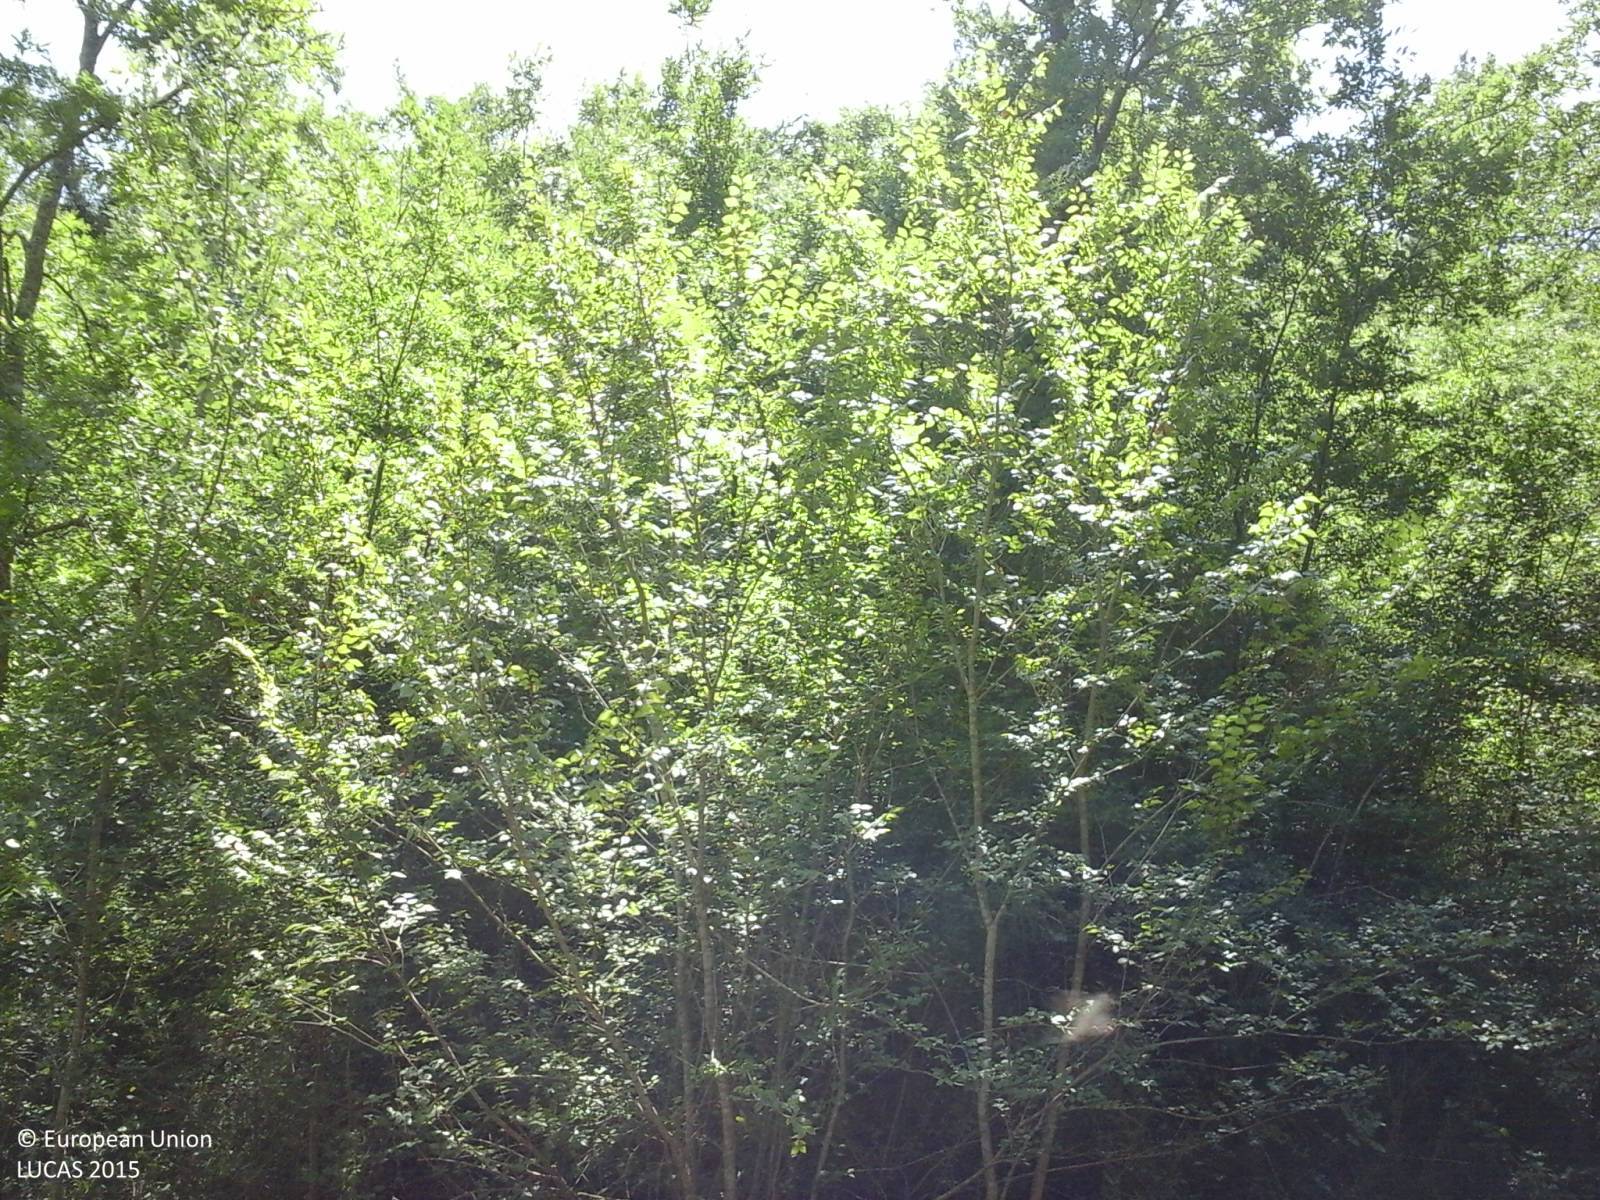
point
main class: Woodland
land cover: Broadleaved woodland
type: thermophilous deciduous forest
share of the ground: > 75 %
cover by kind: broadleaved forest trees 95 %, shrubs 5 %
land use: Forestry
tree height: > 5 m
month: June
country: IT
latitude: 42.6126
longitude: 12.1750
